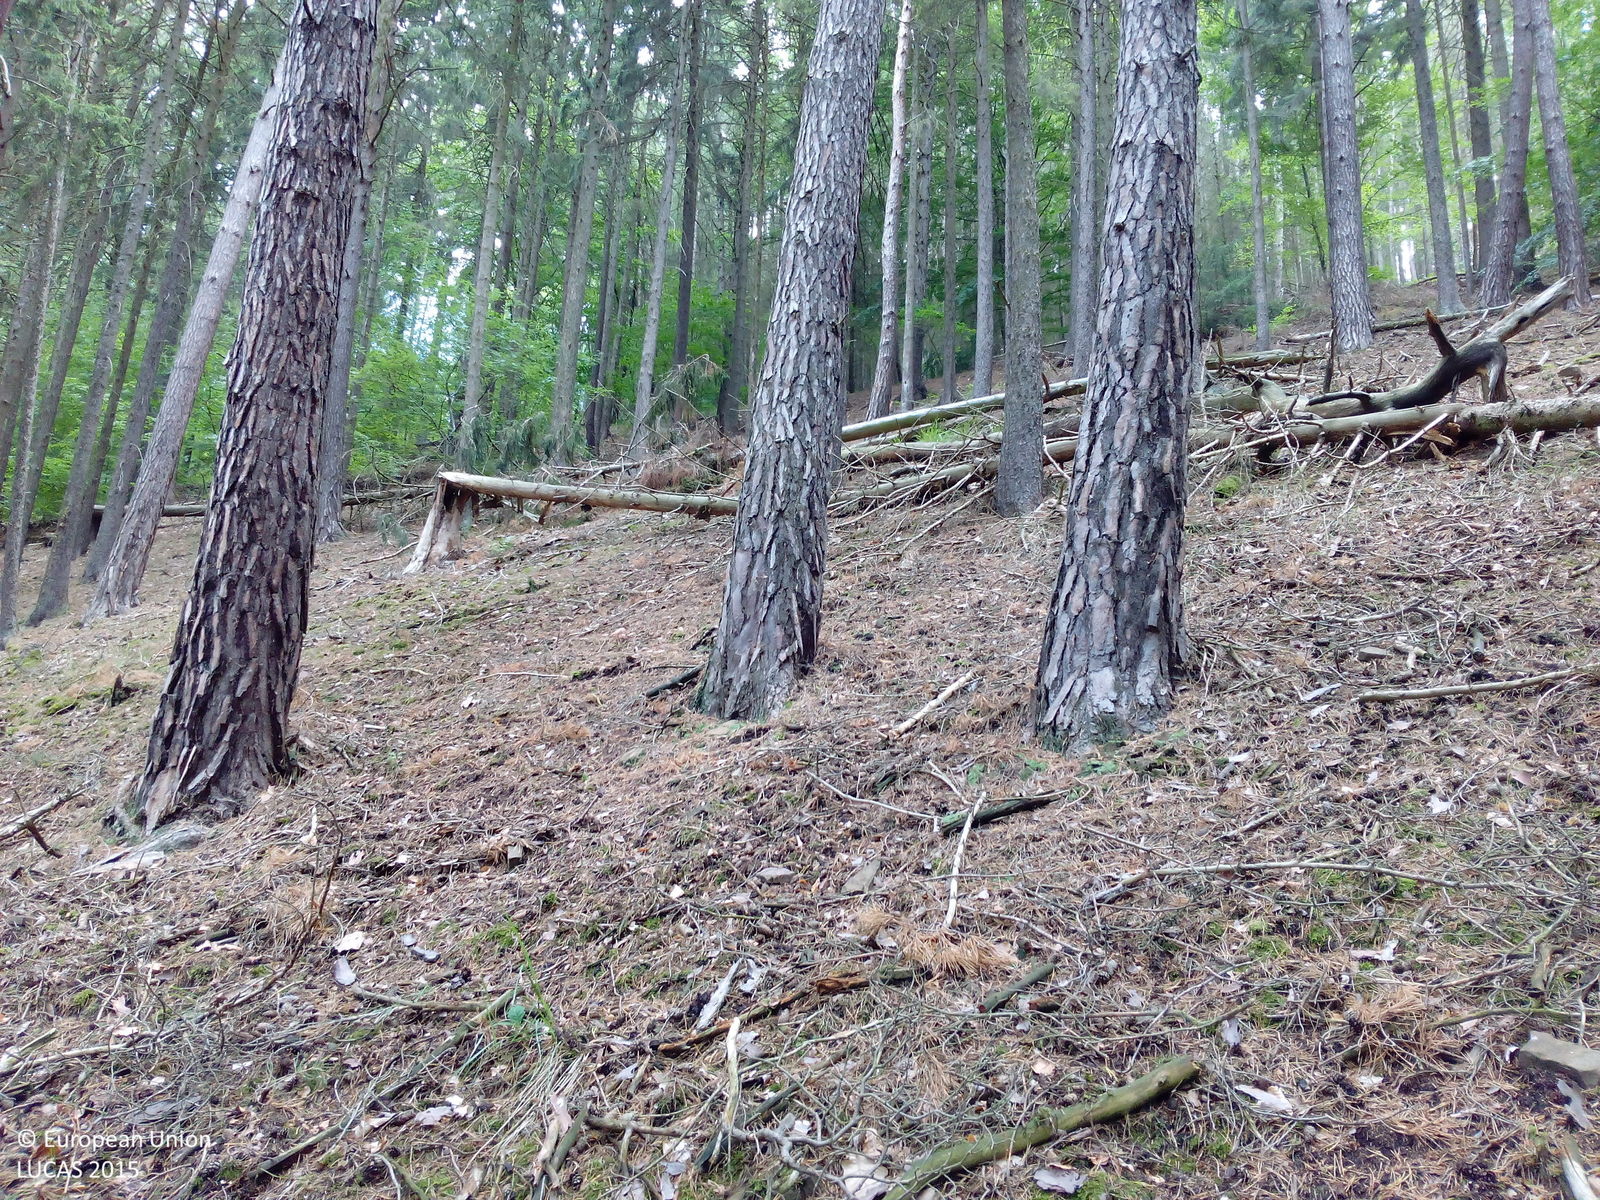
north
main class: Woodland
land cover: Pine dominated coniferous woodland
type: hemiboreal forest and nemoral coniferous forest and mixed broadleaved-coniferous forest
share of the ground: > 75 %
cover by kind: coniferous forest trees 100 %
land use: Forestry
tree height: > 5 m
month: July
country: DE
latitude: 51.6225
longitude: 9.9567
